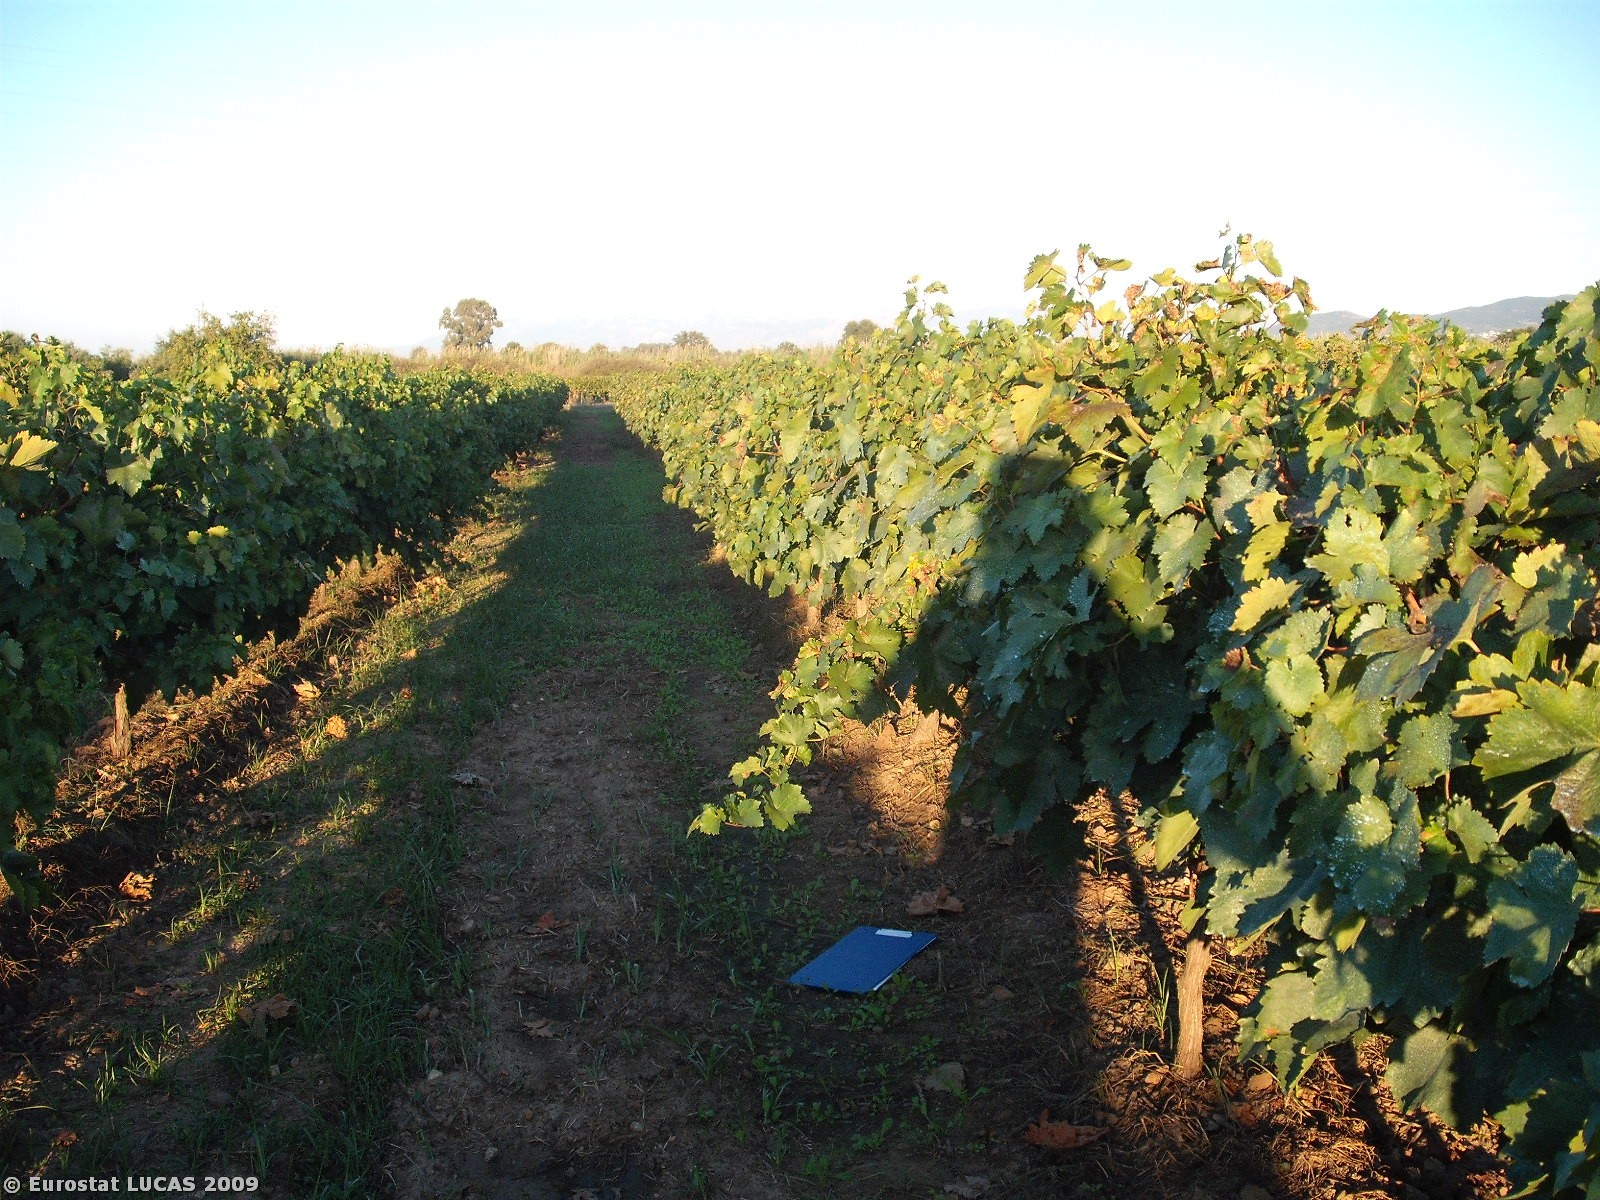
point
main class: Cropland
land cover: Vineyards
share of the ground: 25 - 50 %
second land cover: Grassland with sparse tree/shrub cover
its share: 50 - 75 %
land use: Agriculture (excluding fallow land and kitchen gardens)
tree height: < 5 m
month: October
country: GR
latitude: 38.0788
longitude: 21.4437
